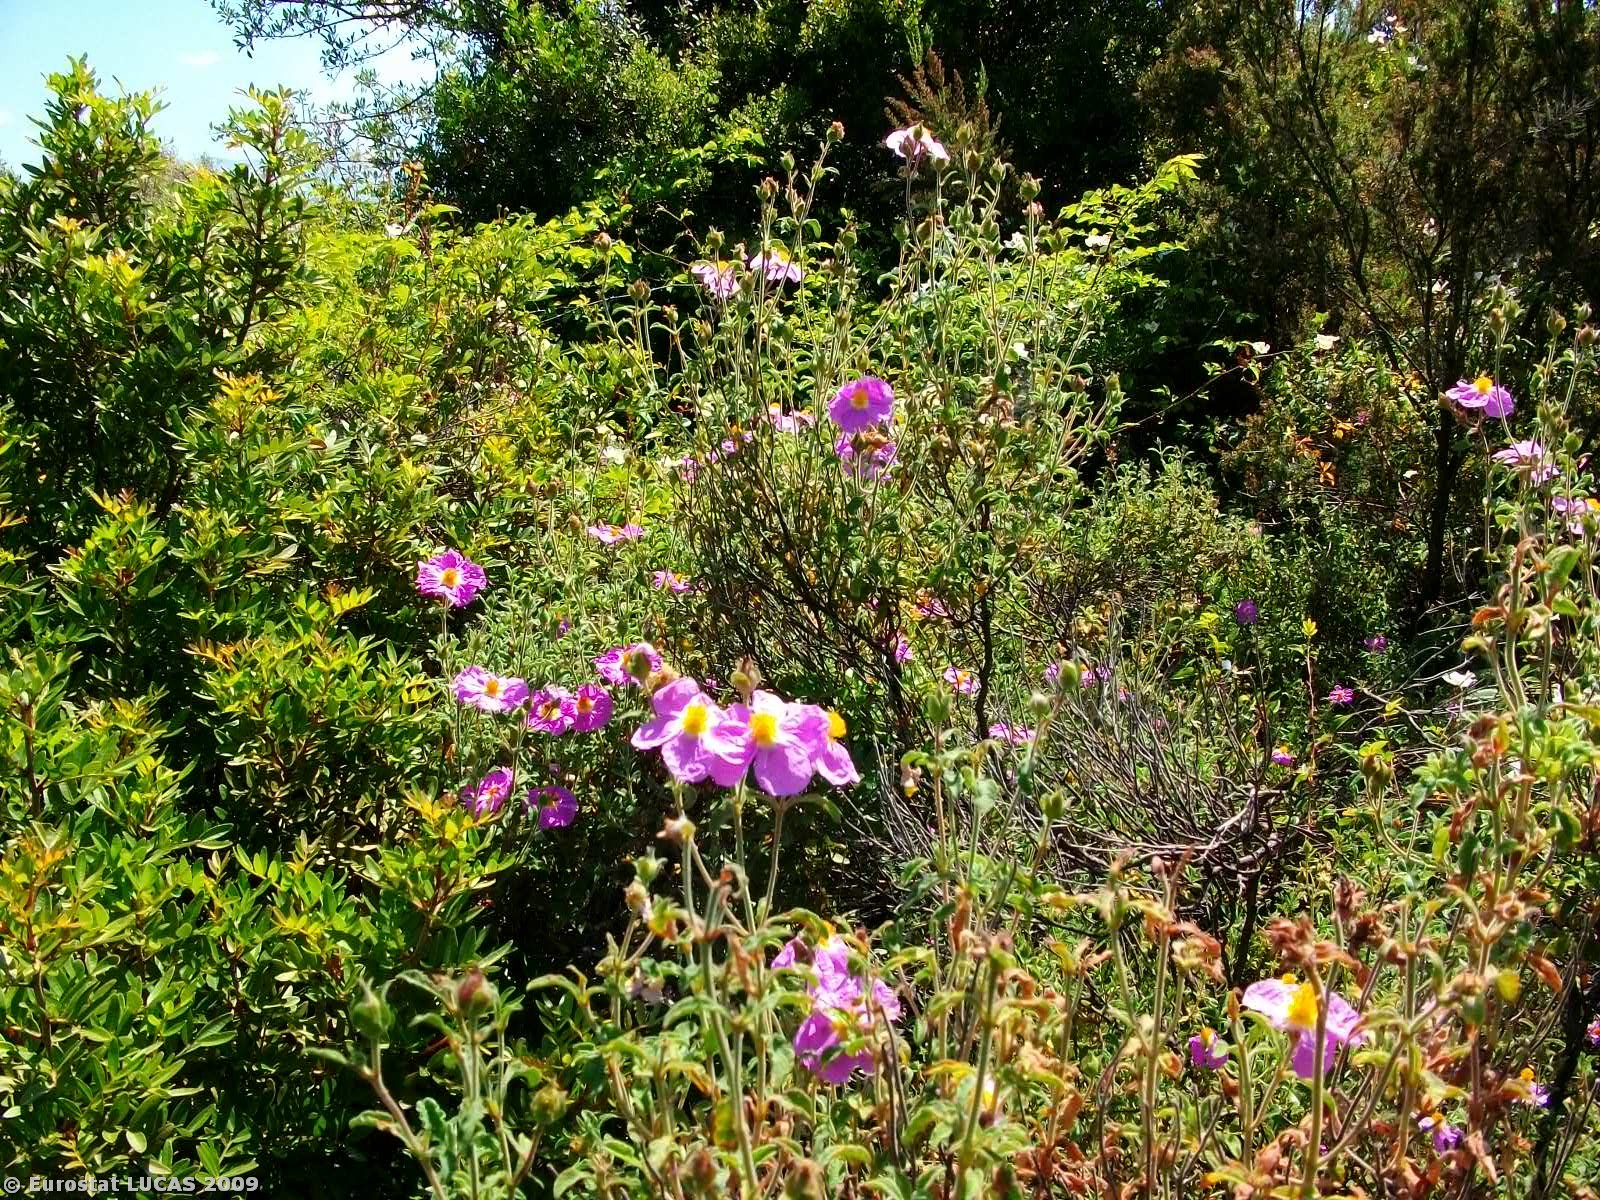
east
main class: Shrubland
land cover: Shrubland with sparse tree cover
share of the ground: > 75 %
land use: Unused
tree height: < 5 m
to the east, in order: Shrubland with sparse tree cover; Grass margins; Paved roads, cycling and walking lanes; Olive groves; Shrubland with sparse tree cover; Olive groves; Tracks; Shrubland with sparse tree cover; Tracks; Shrubland with sparse tree cover
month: May
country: GR
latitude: 38.6628
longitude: 21.4516
